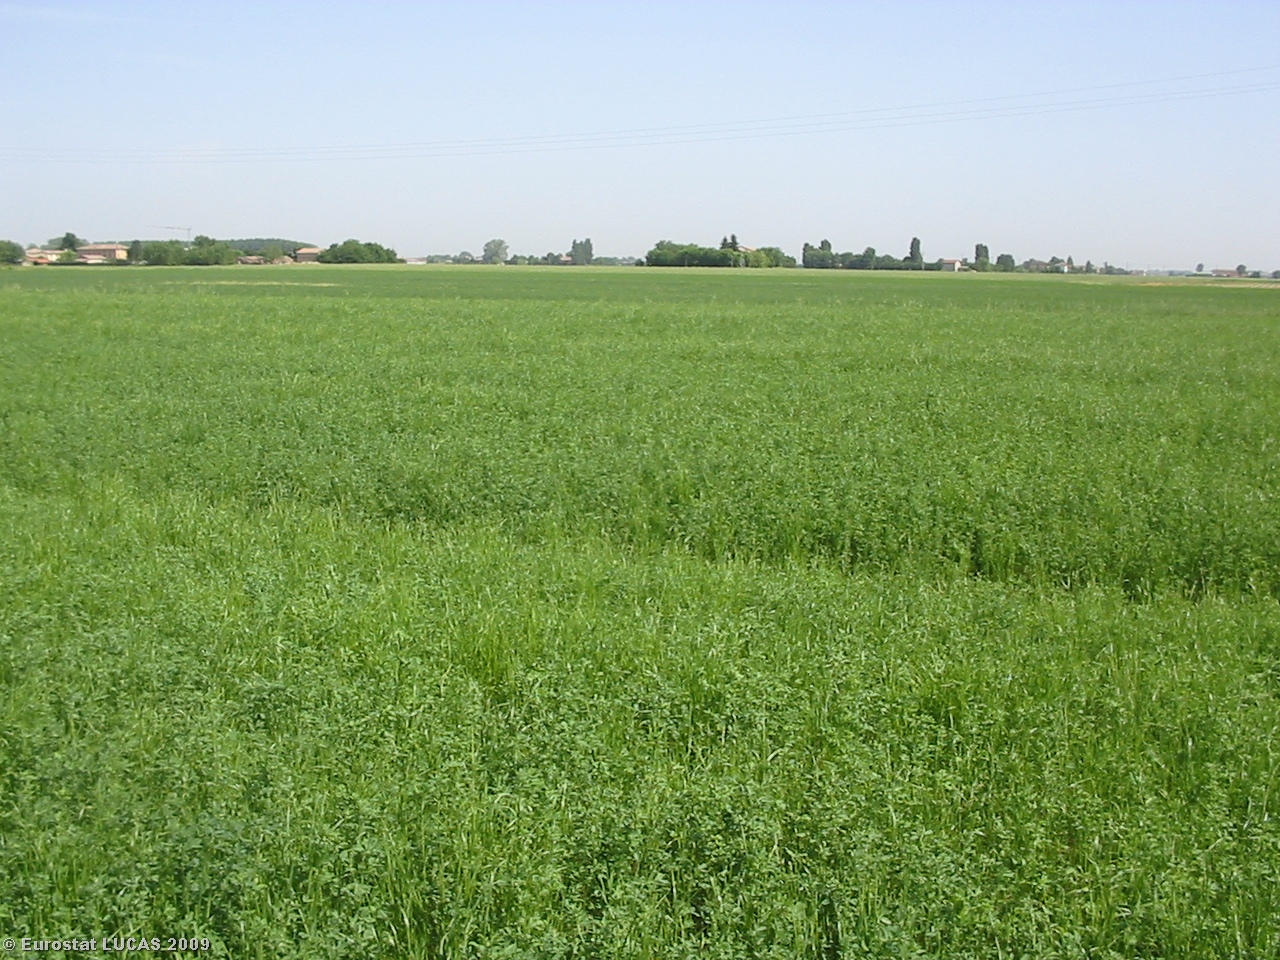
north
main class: Cropland
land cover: Lucerne
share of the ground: > 75 %
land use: Agriculture (excluding fallow land and kitchen gardens)
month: May
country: IT
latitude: 44.8730
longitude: 10.3411
